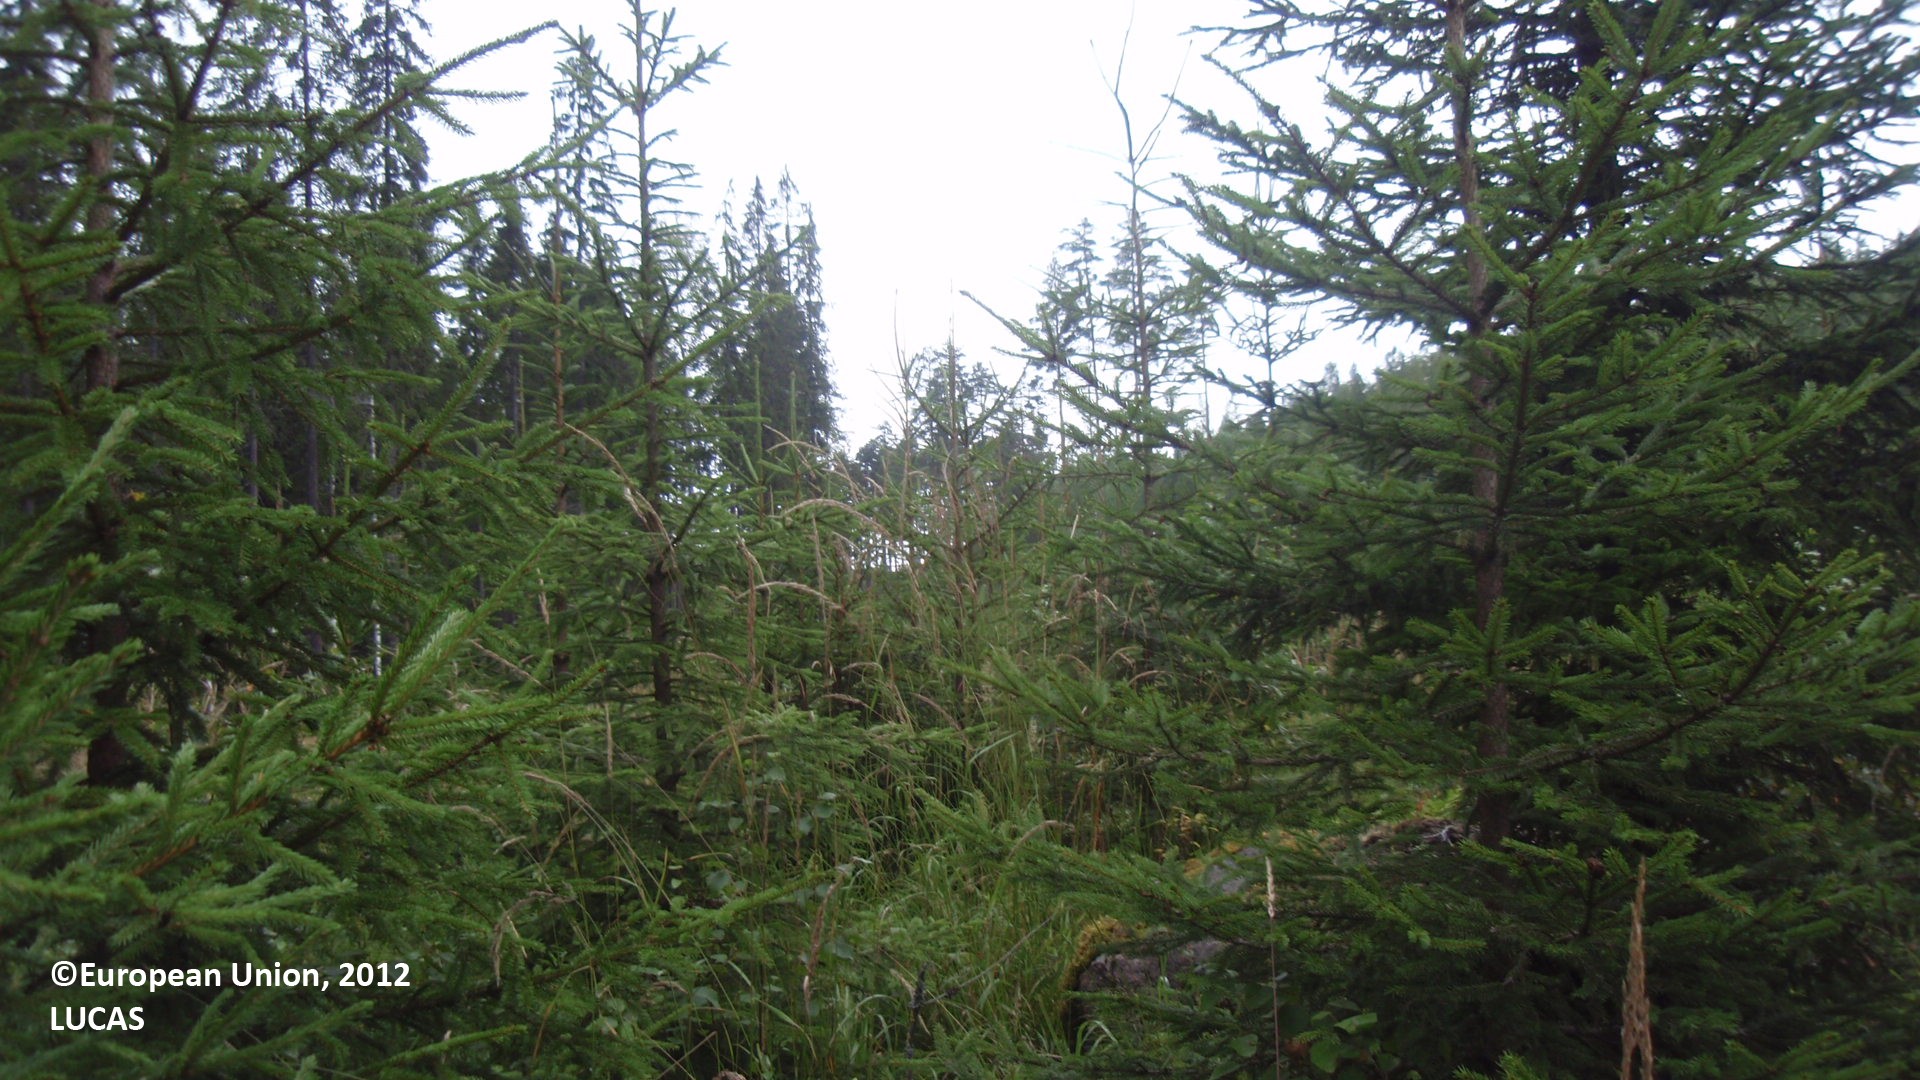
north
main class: Woodland
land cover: Spruce dominated mixed woodland
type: boreal forest
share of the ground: 25 - 50 %
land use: Forestry
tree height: < 5 m
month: August
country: FI
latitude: 60.9070
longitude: 27.4952
